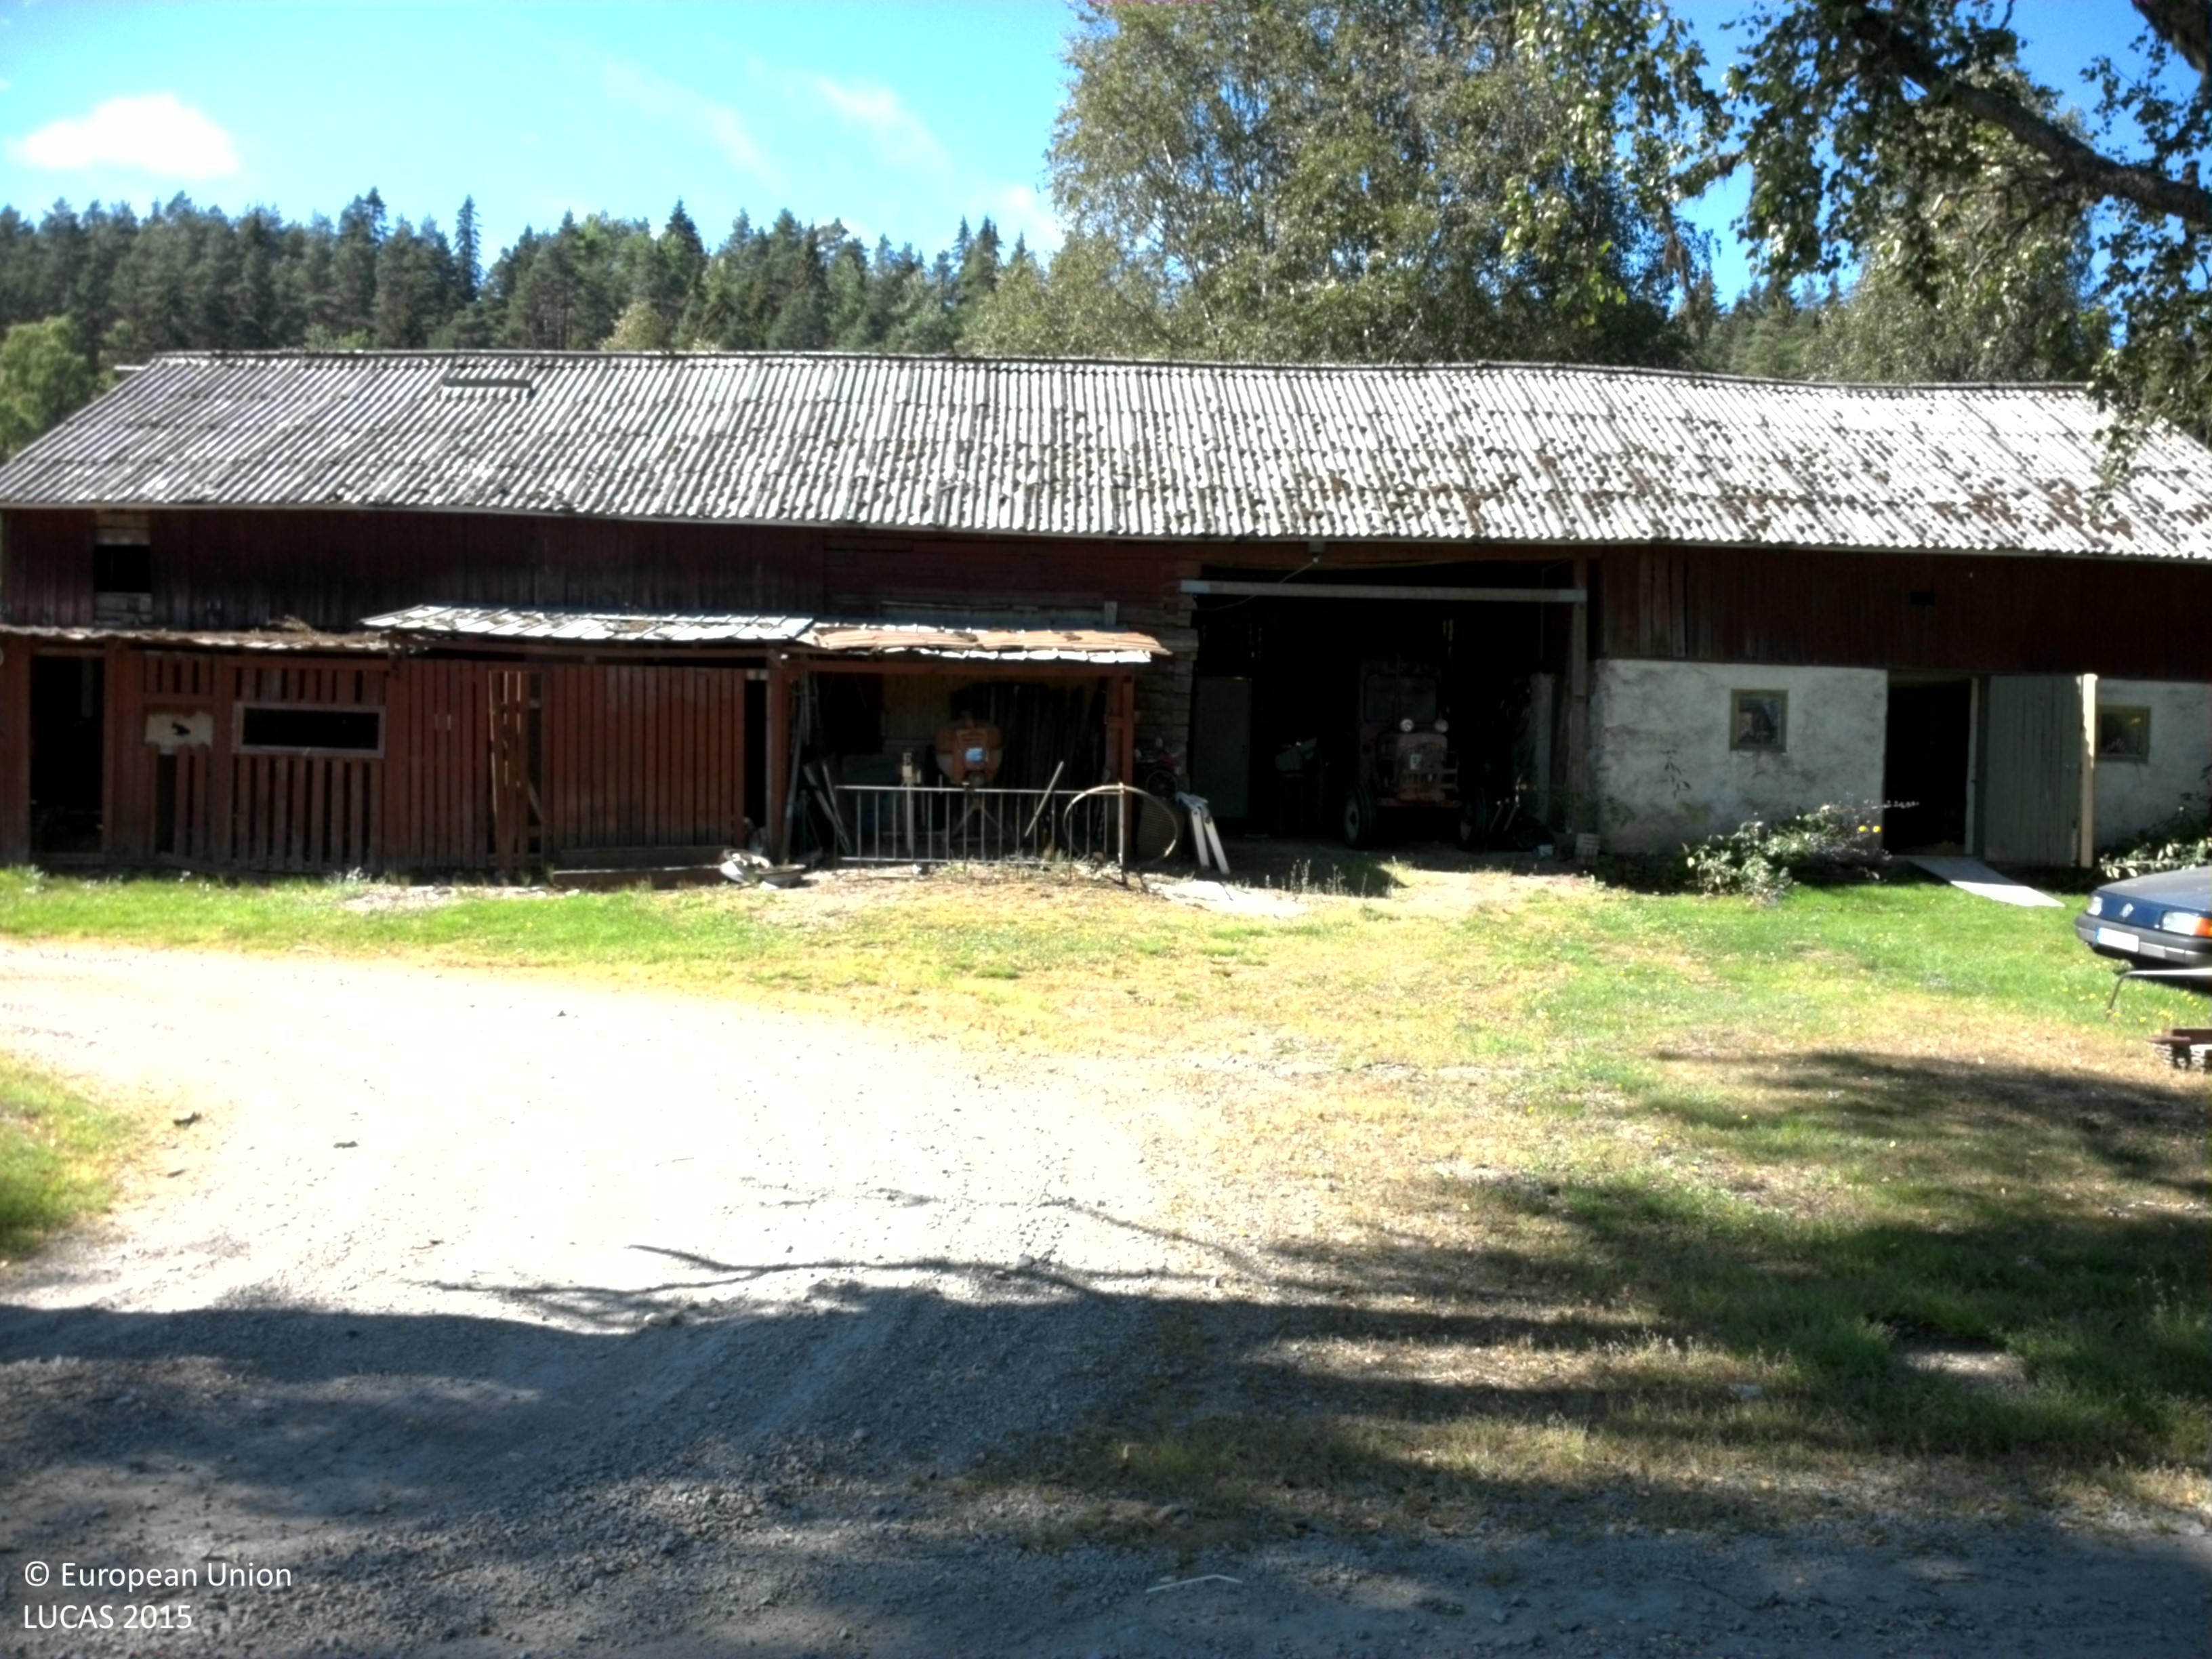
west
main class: Grassland
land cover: Grassland without tree/shrub cover
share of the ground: > 75 %
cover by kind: herbaceous plants 90 %, consolidated bare surface 10 %
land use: Agriculture (excluding fallow land and kitchen gardens)
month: August
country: SE
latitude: 59.4264
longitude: 12.1273
